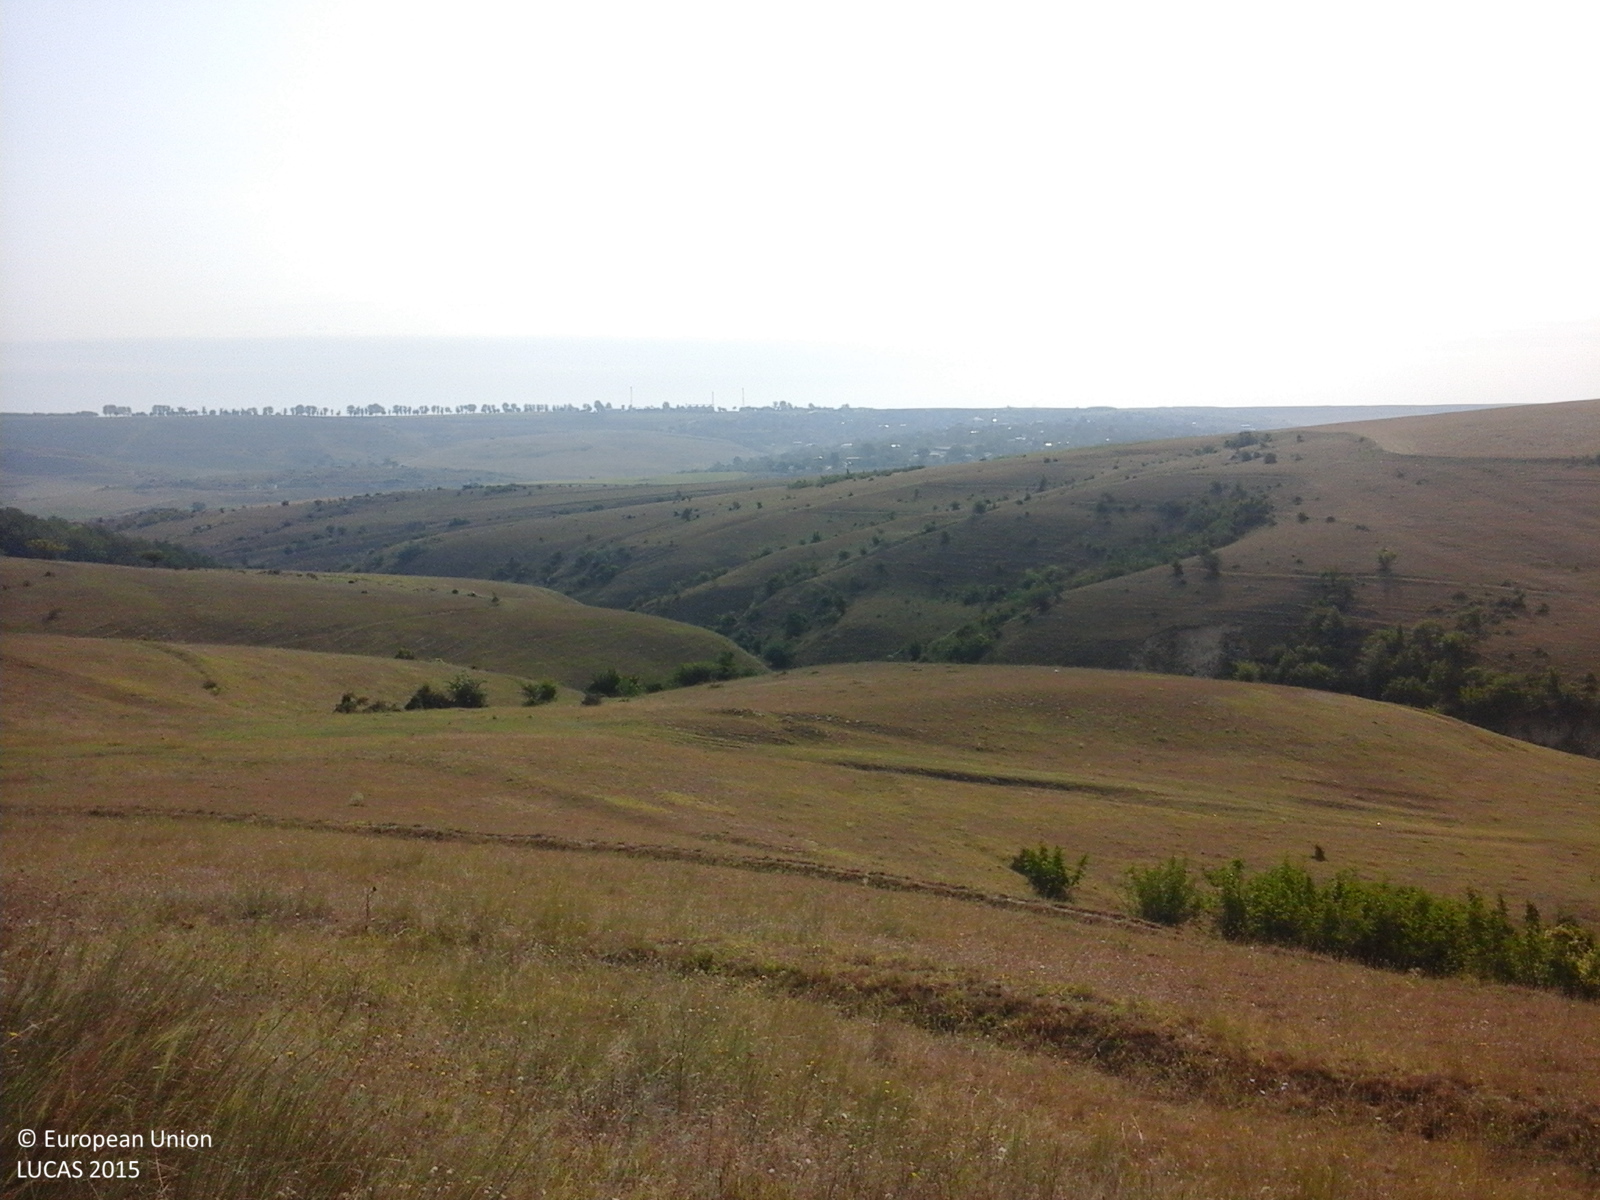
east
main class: Grassland
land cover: Grassland without tree/shrub cover
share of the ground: > 75 %
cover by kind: herbaceous plants 100 %
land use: Agriculture (excluding fallow land and kitchen gardens)
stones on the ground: < 10 %
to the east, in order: Grassland without tree/shrub cover; Grassland with sparse tree/shrub cover; Grassland without tree/shrub cover; Grassland with sparse tree/shrub cover; Ditches and canals; Sand; Grassland with sparse tree/shrub cover
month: August
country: RO
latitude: 44.0839
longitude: 27.9217
